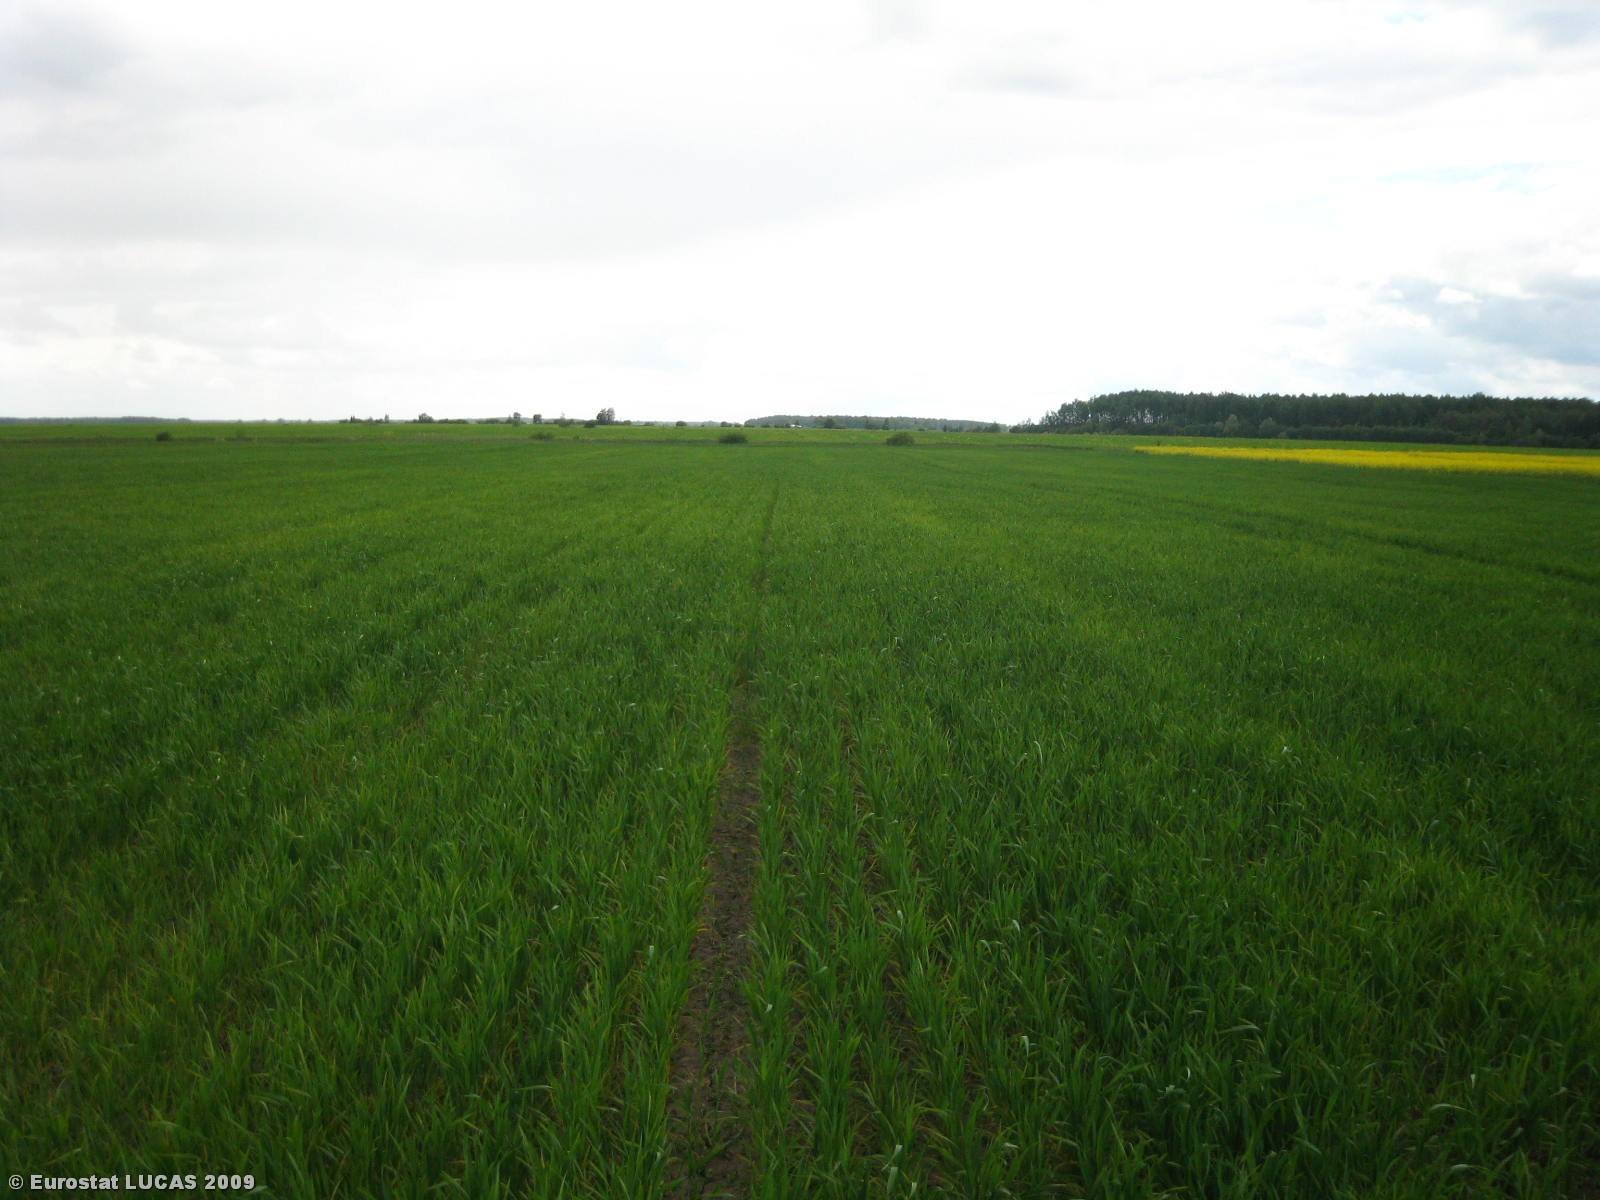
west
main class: Cropland
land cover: Common wheat
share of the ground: > 75 %
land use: Agriculture (excluding fallow land and kitchen gardens)
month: May
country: LT
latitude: 56.0117
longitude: 24.0590
